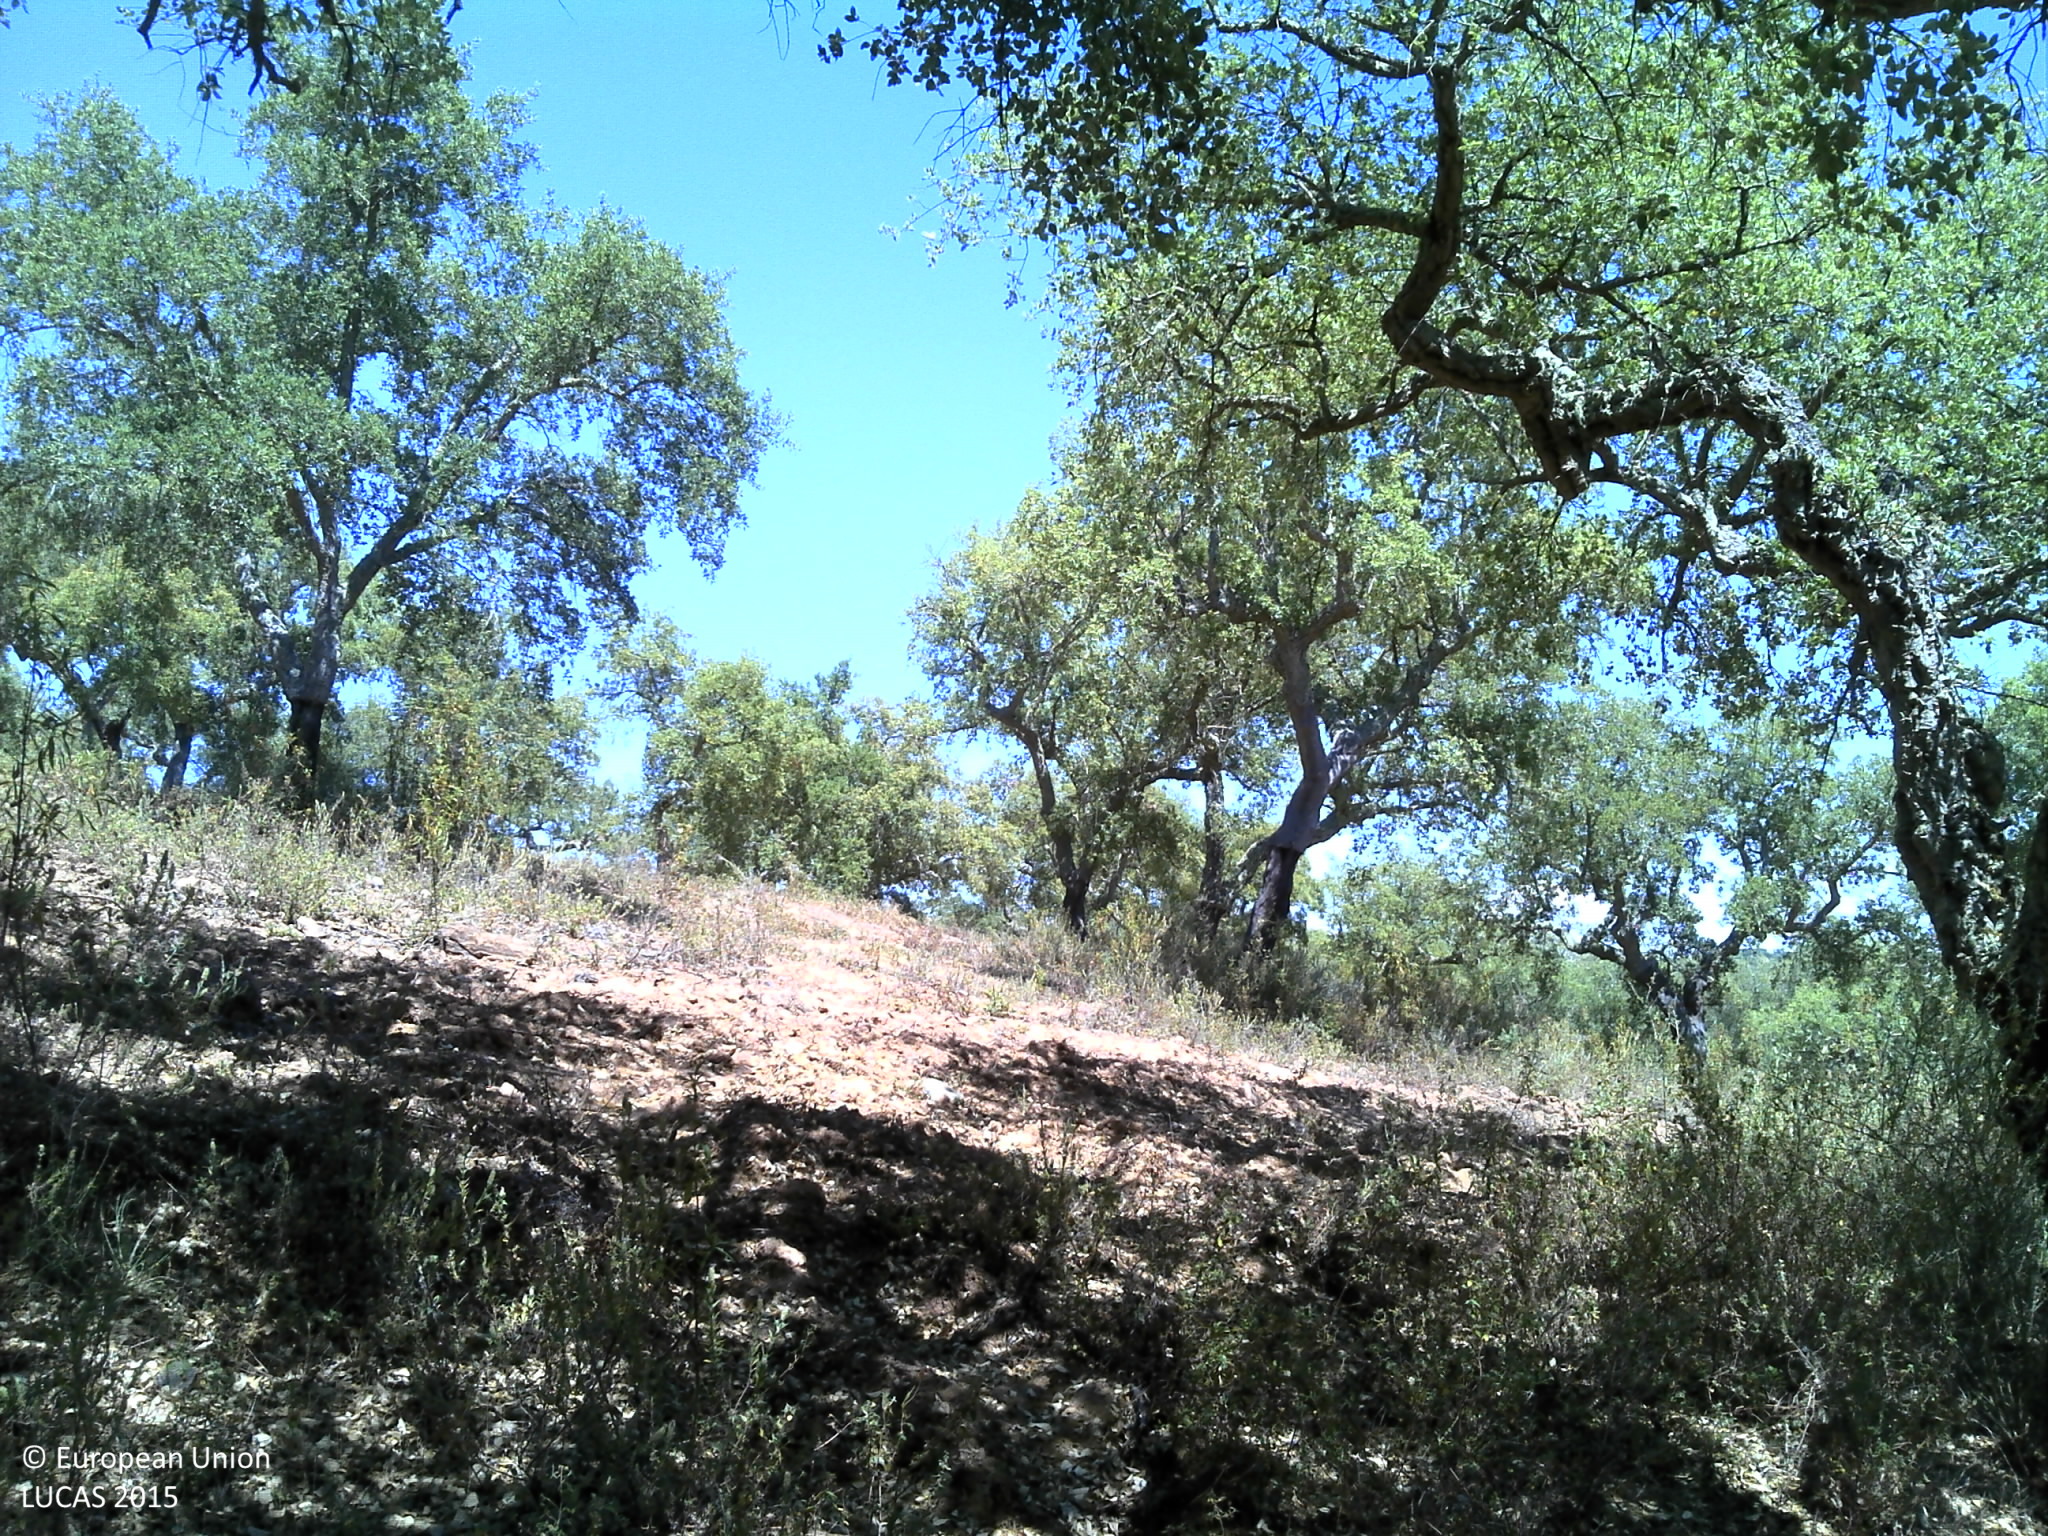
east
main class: Woodland
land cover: Broadleaved woodland
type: broadleaved evergreen forest
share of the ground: 25 - 50 %
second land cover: Grassland without tree/shrub cover
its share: 10 - 25 %
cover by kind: broadleaved forest trees 50 %, unconsolidated bare surface 35 %, herbaceous plants 15 %
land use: Forestry
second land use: Agriculture (excluding fallow land and kitchen gardens)
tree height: > 5 m
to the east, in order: Broadleaved woodland; Grassland without tree/shrub cover; Tracks; Broadleaved woodland; Tracks; Broadleaved woodland
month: June
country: PT
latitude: 38.7851
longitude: -7.7332
